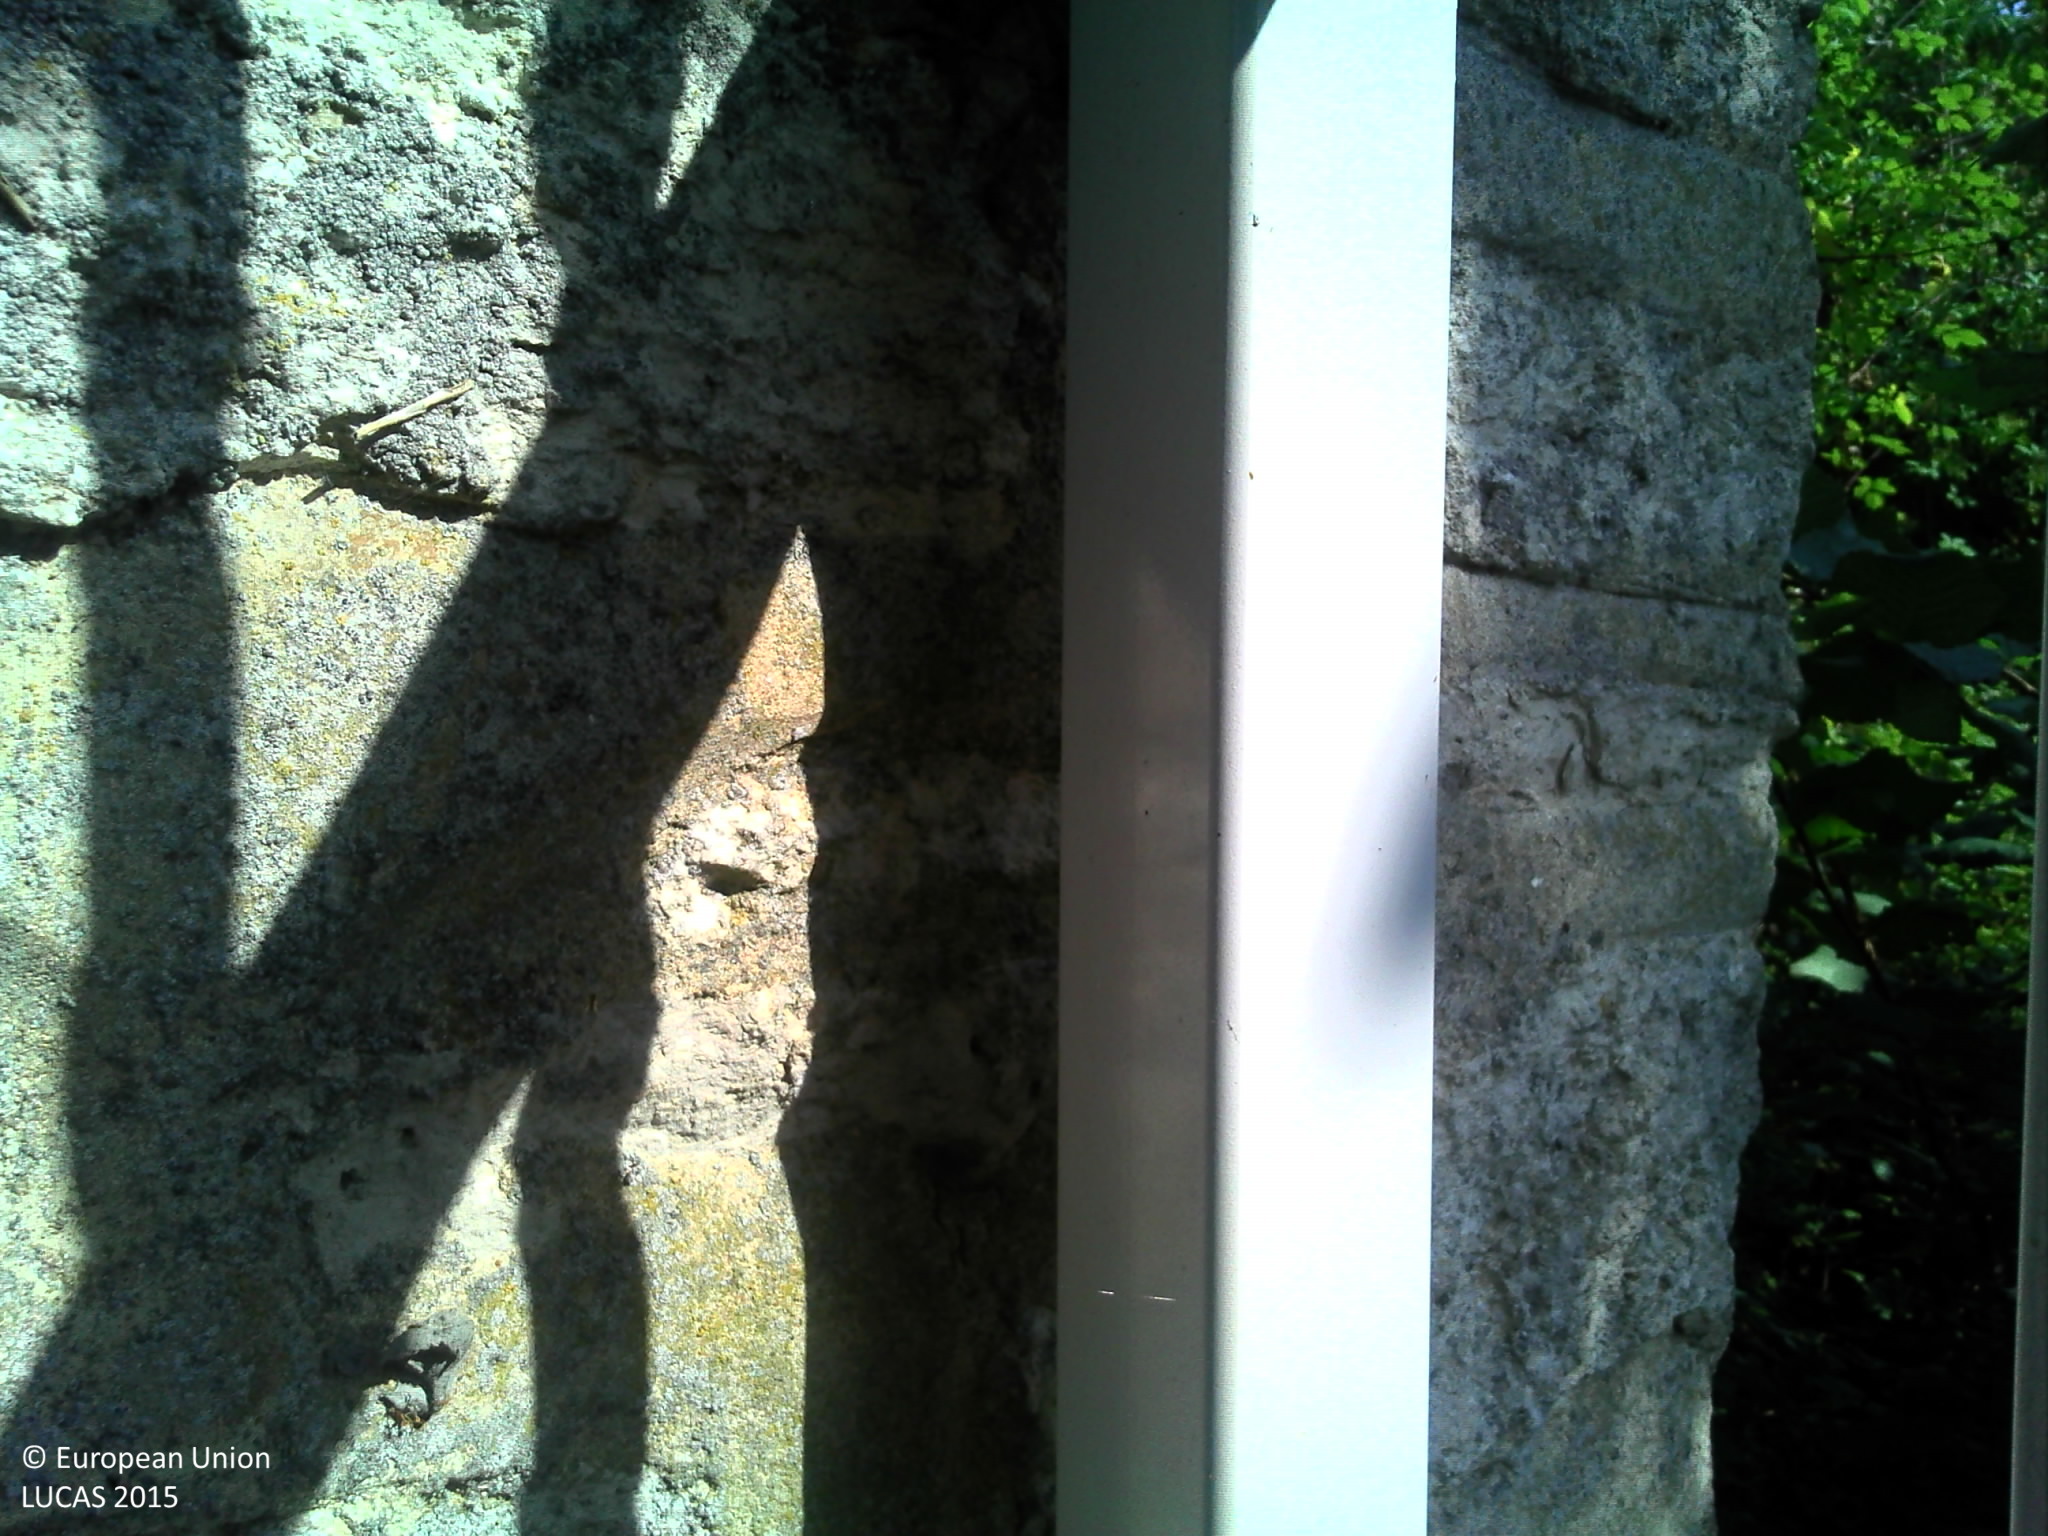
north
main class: Woodland
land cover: Broadleaved woodland
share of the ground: > 75 %
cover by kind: broadleaved forest trees 100 %
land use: Semi-natural and natural areas not in use
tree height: > 5 m
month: July
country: FR
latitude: 47.8625
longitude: 2.8143
